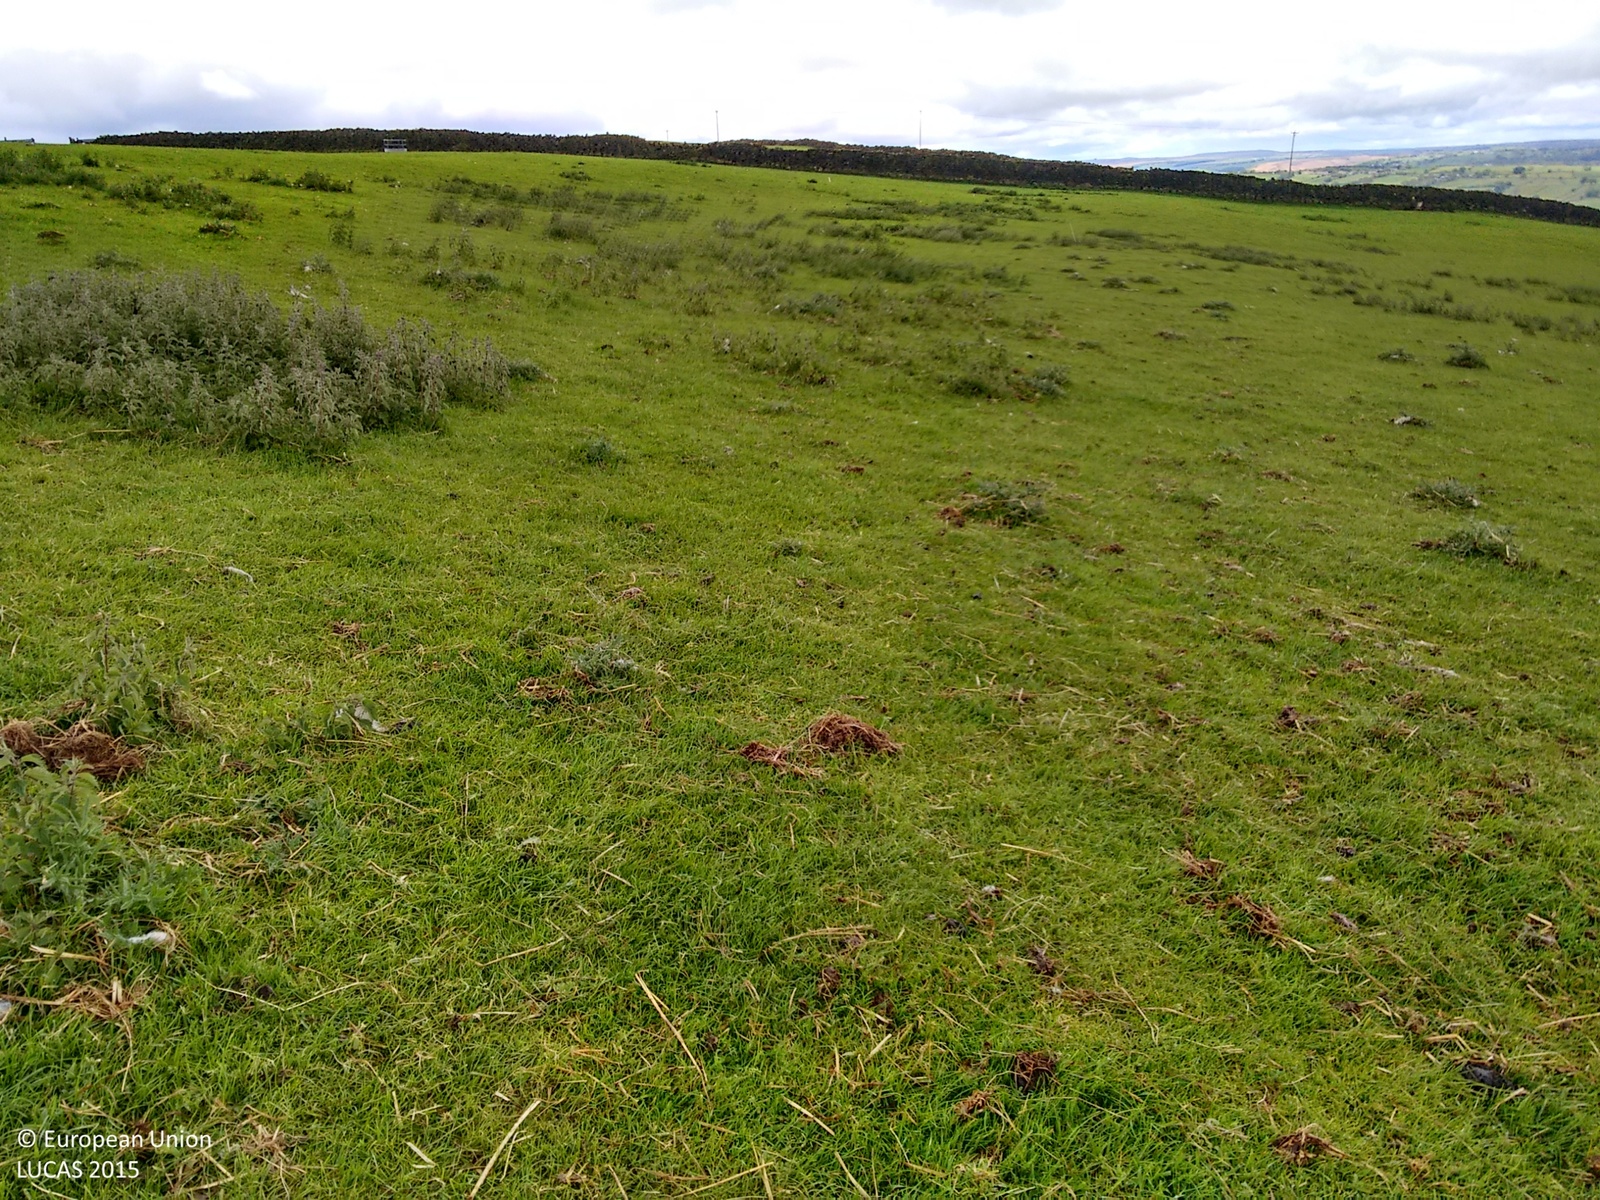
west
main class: Grassland
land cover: Grassland without tree/shrub cover
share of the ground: > 75 %
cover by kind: herbaceous plants 100 %
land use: Agriculture (excluding fallow land and kitchen gardens)
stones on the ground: < 10 %
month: May
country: GB
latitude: 53.9406
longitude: -1.7064
